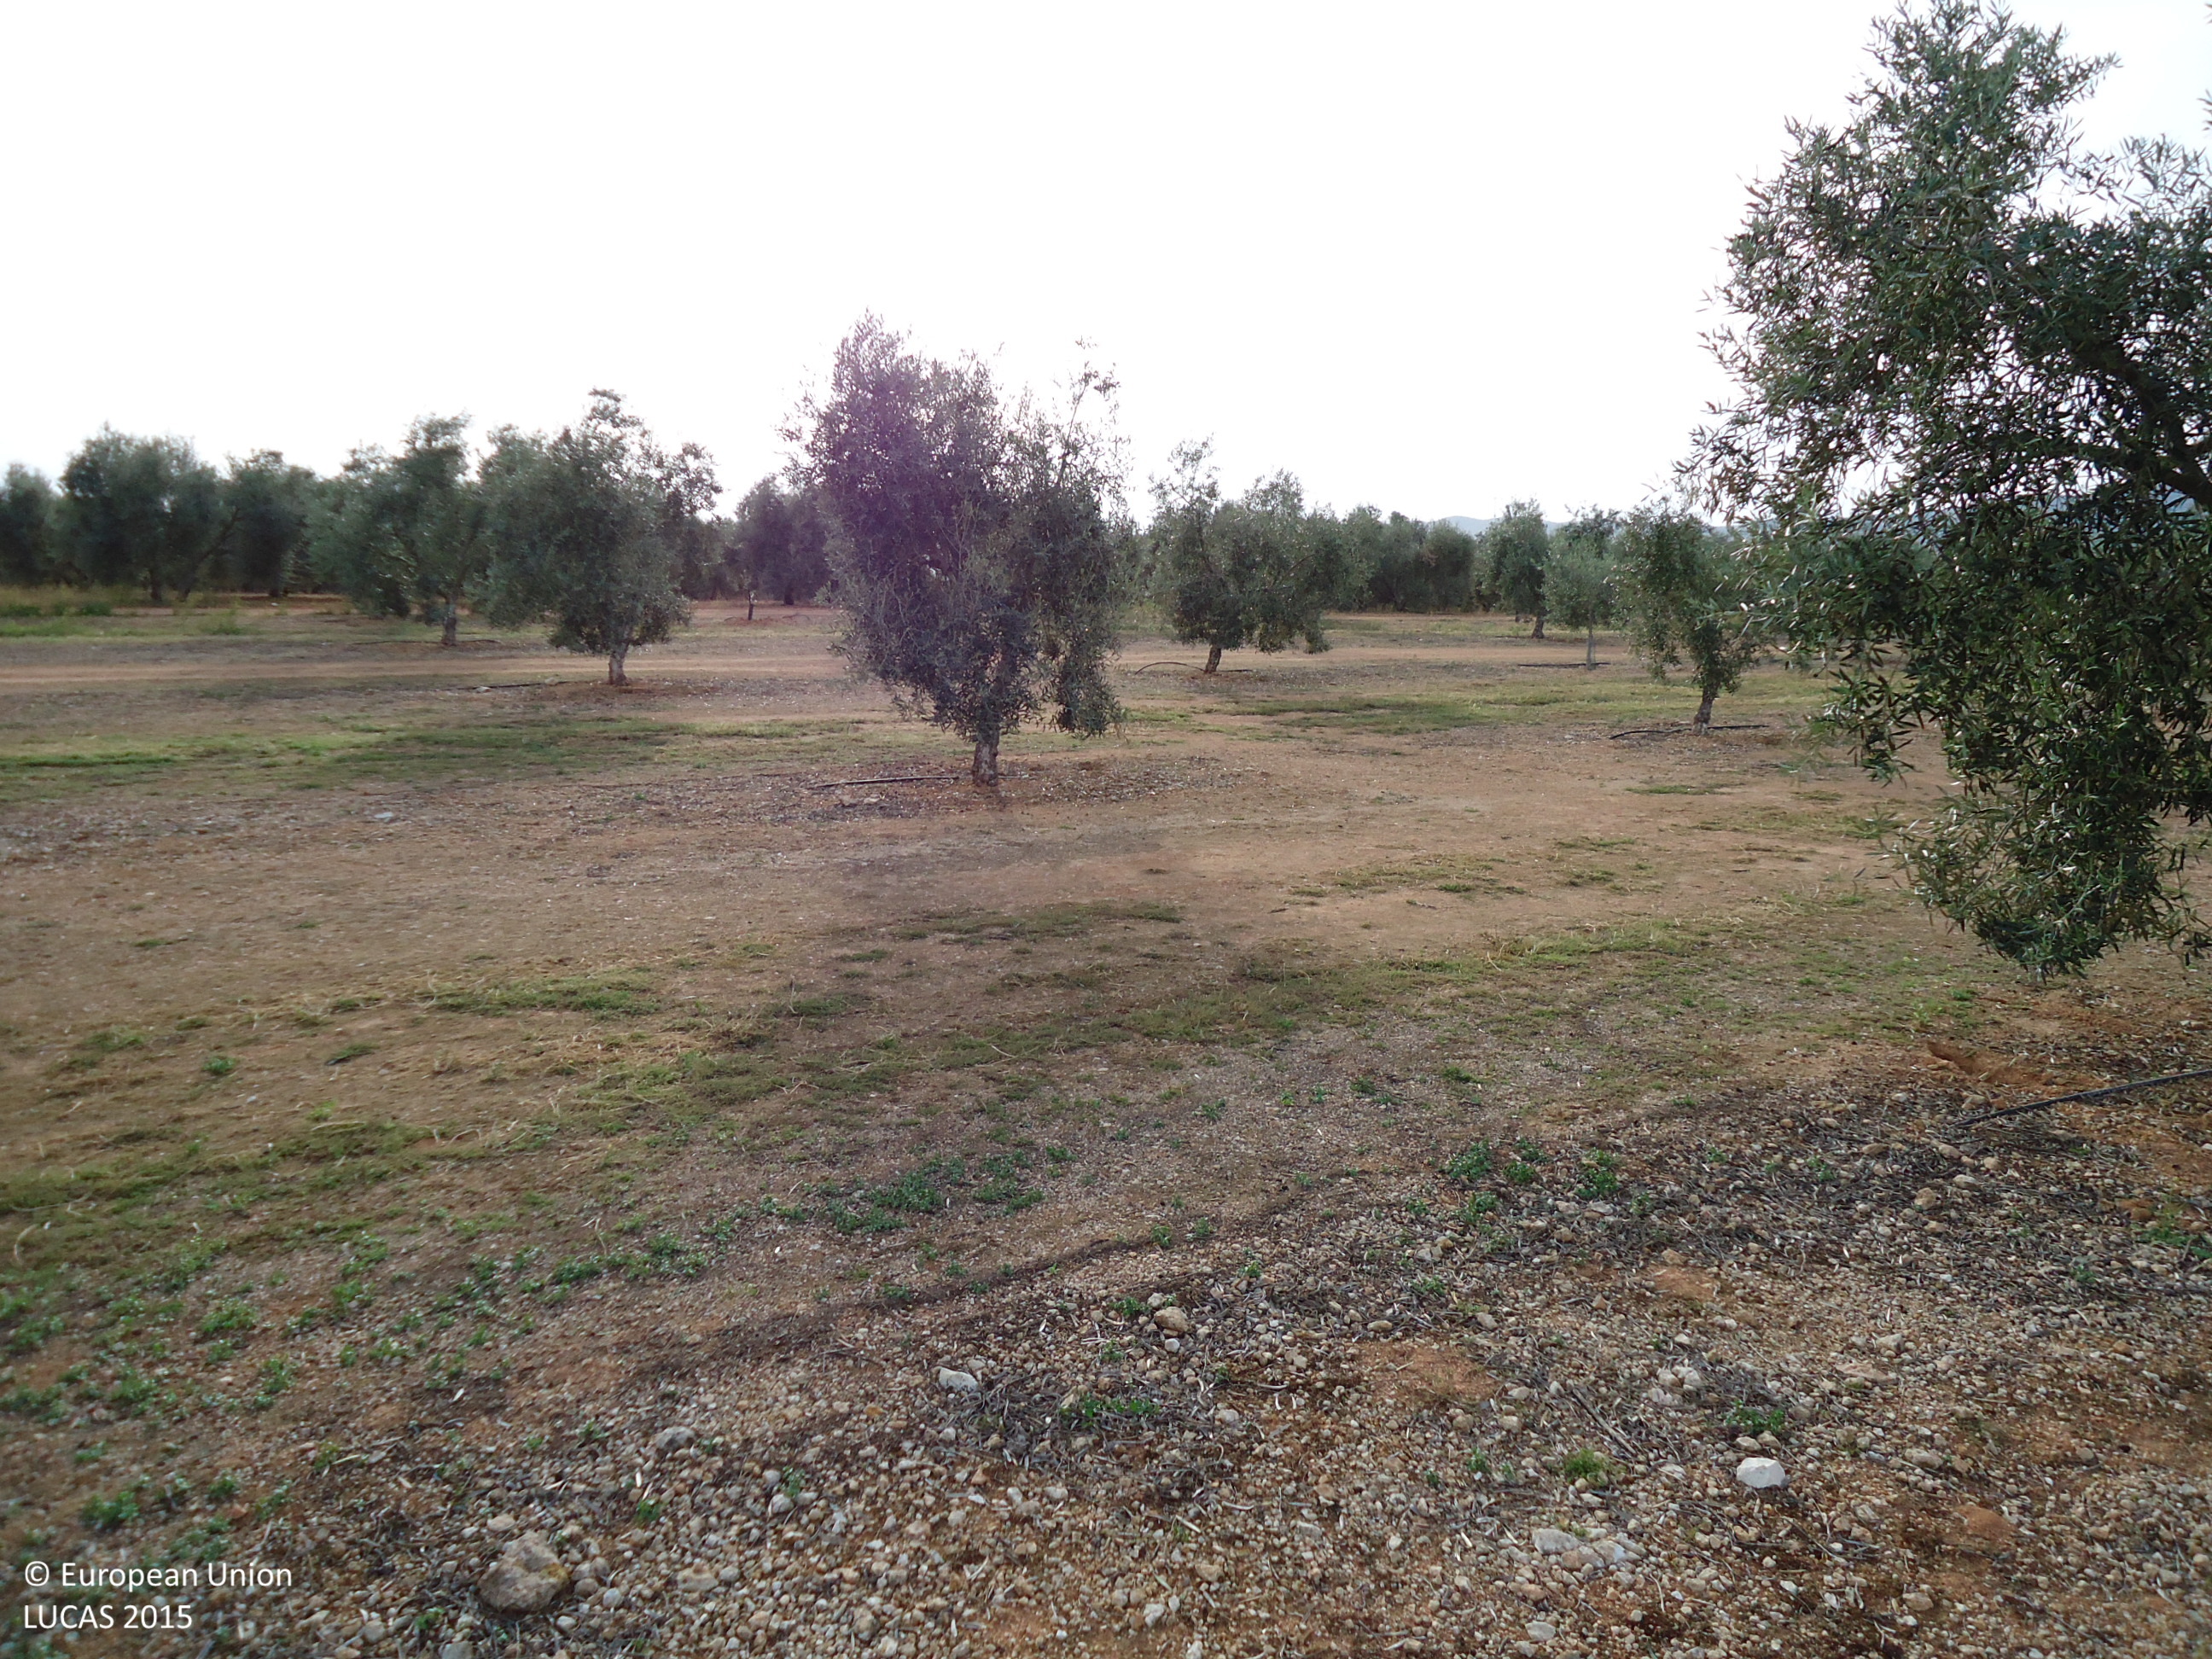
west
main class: Cropland
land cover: Olive groves
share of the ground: 10 - 25 %
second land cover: Spontaneously vegetated surfaces
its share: 10 - 25 %
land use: Agriculture (excluding fallow land and kitchen gardens)
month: April
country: ES
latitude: 37.1516
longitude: -4.8082
